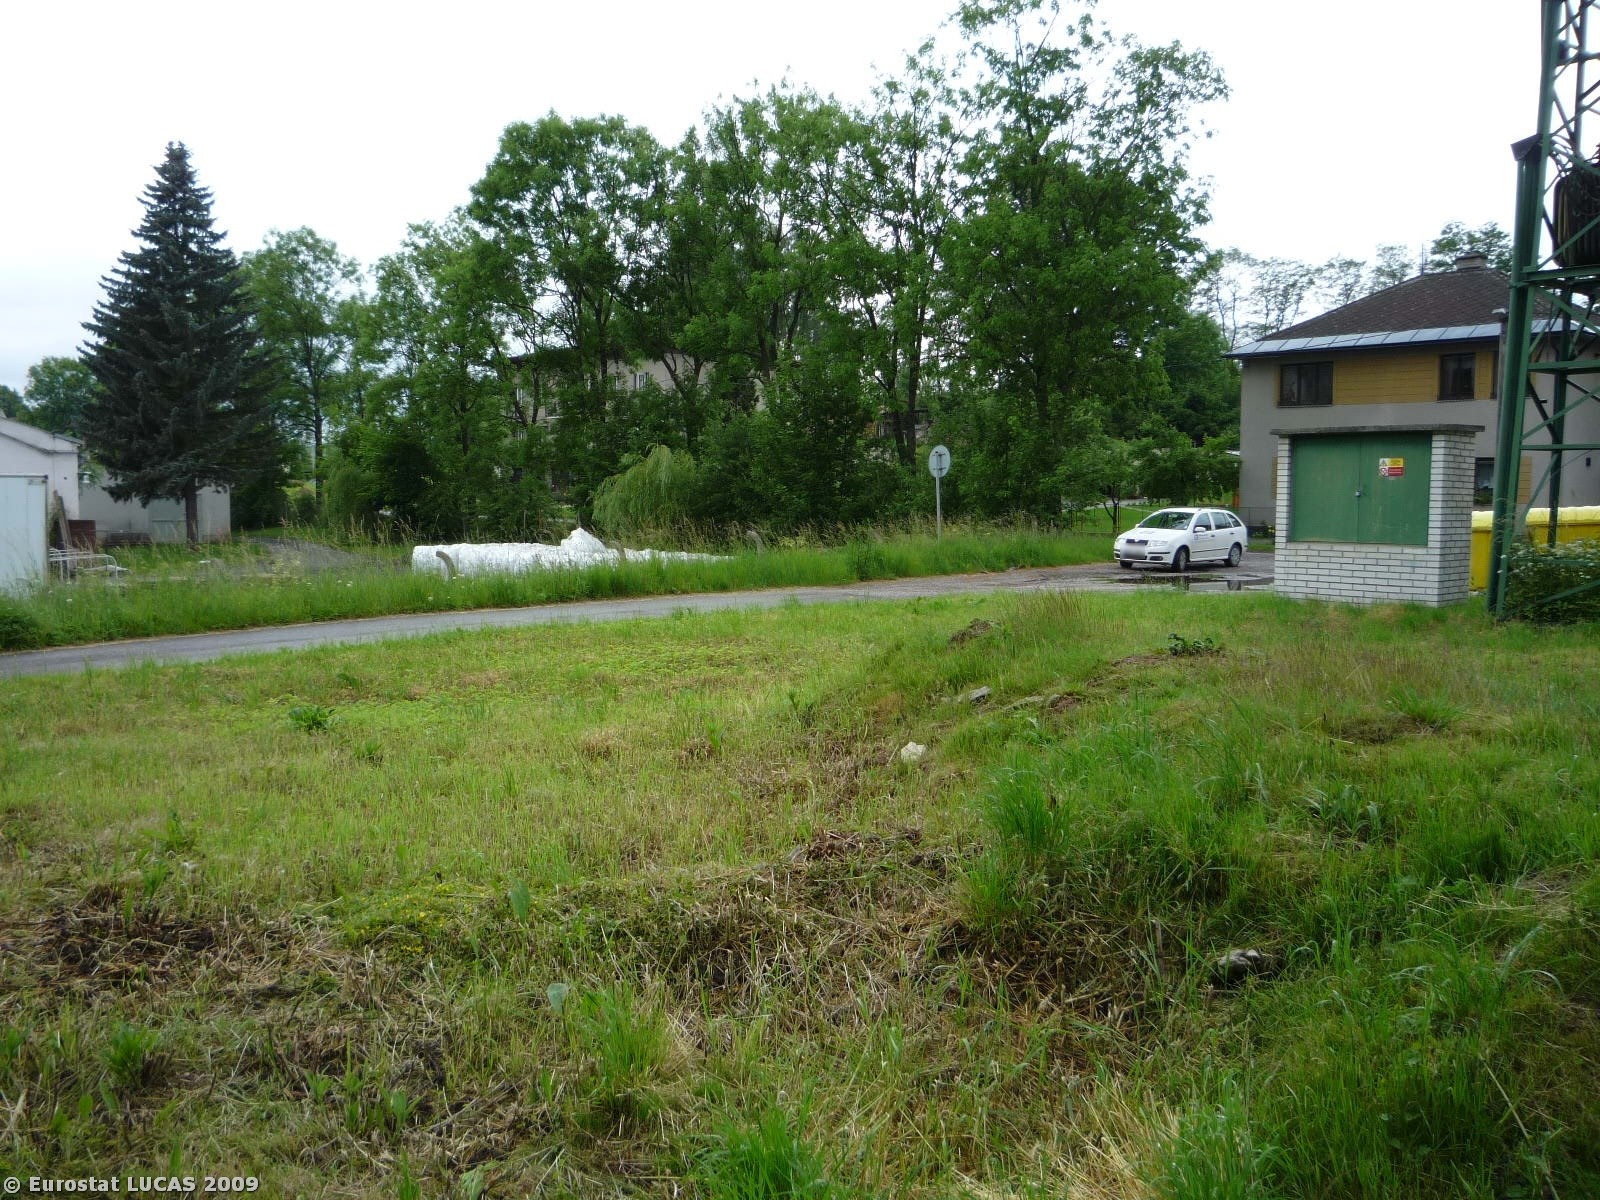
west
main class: Grassland
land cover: Grassland without tree/shrub cover
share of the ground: > 75 %
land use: Unused
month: June
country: CZ
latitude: 50.5564
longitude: 15.4950
